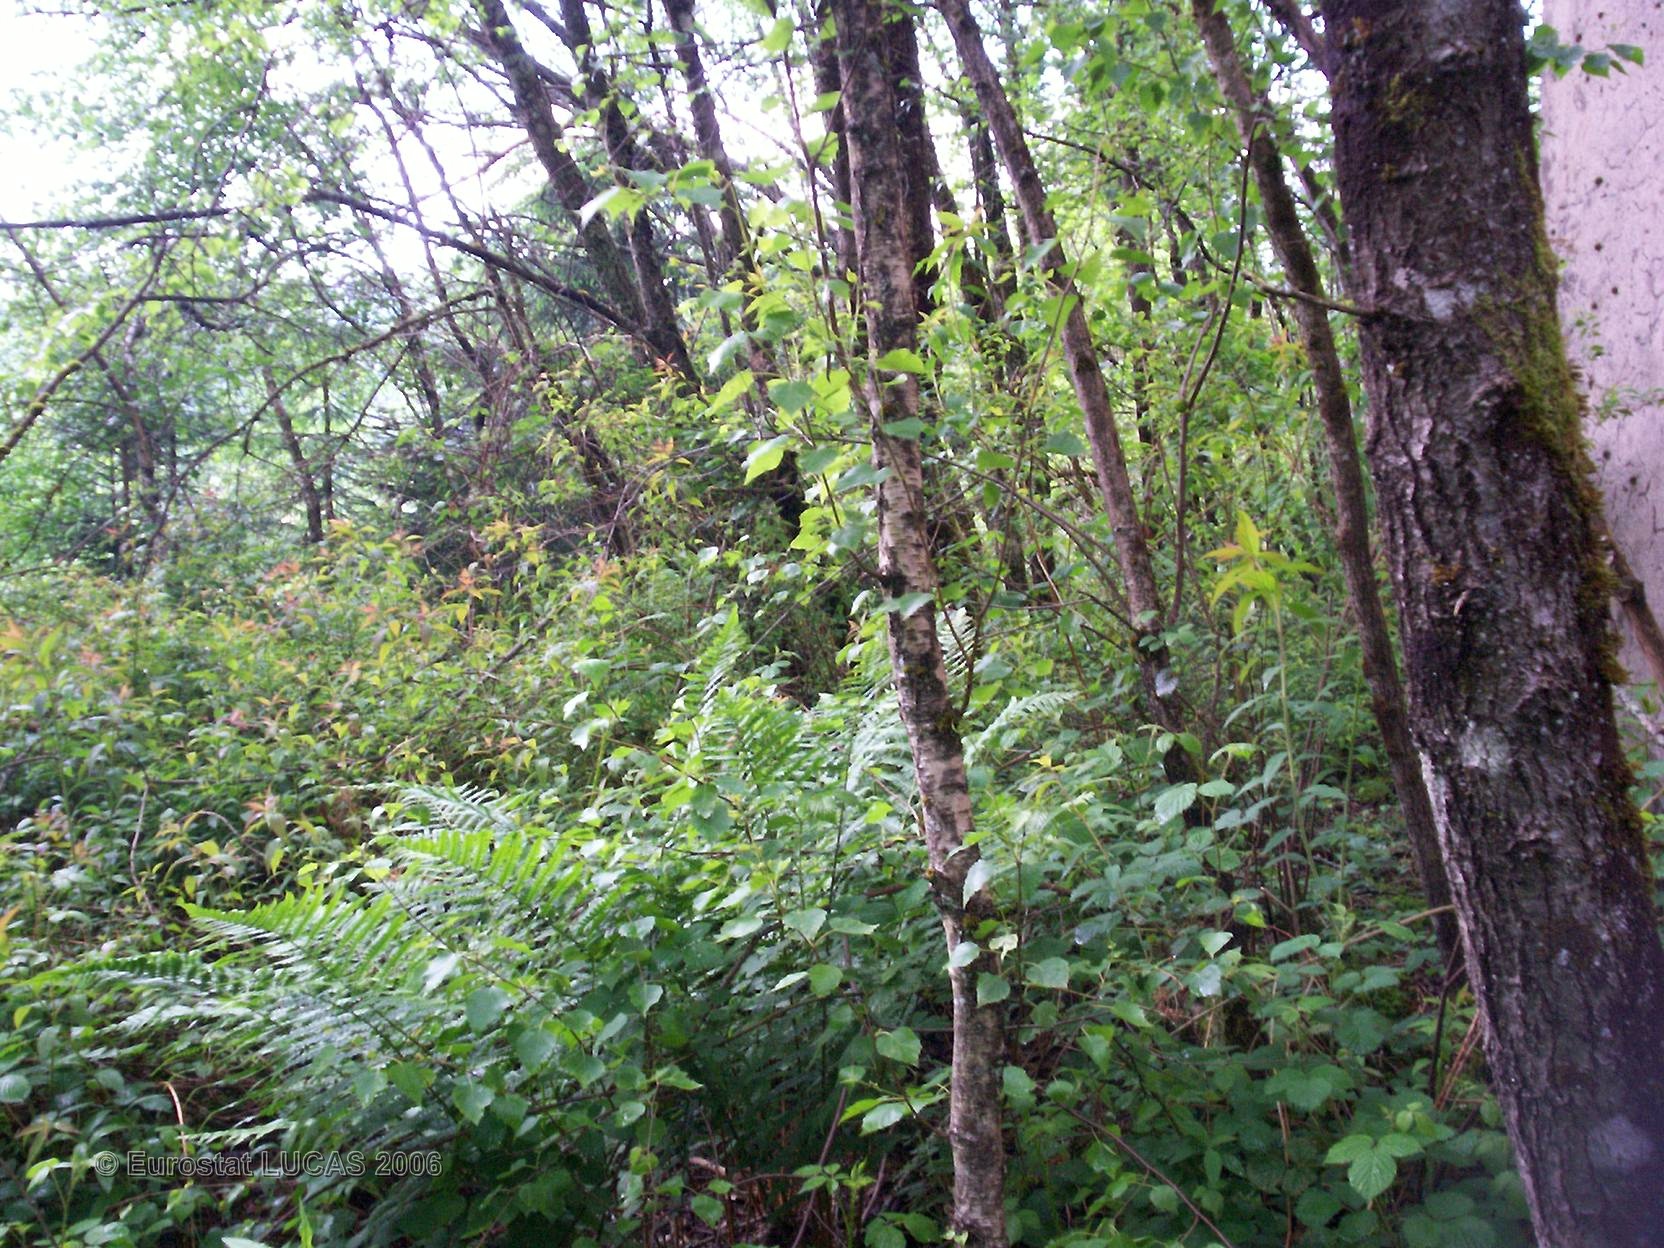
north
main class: Woodland
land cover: Broadleaved forest
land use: Unused
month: June
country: FR
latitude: 47.9423
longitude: 6.7747
